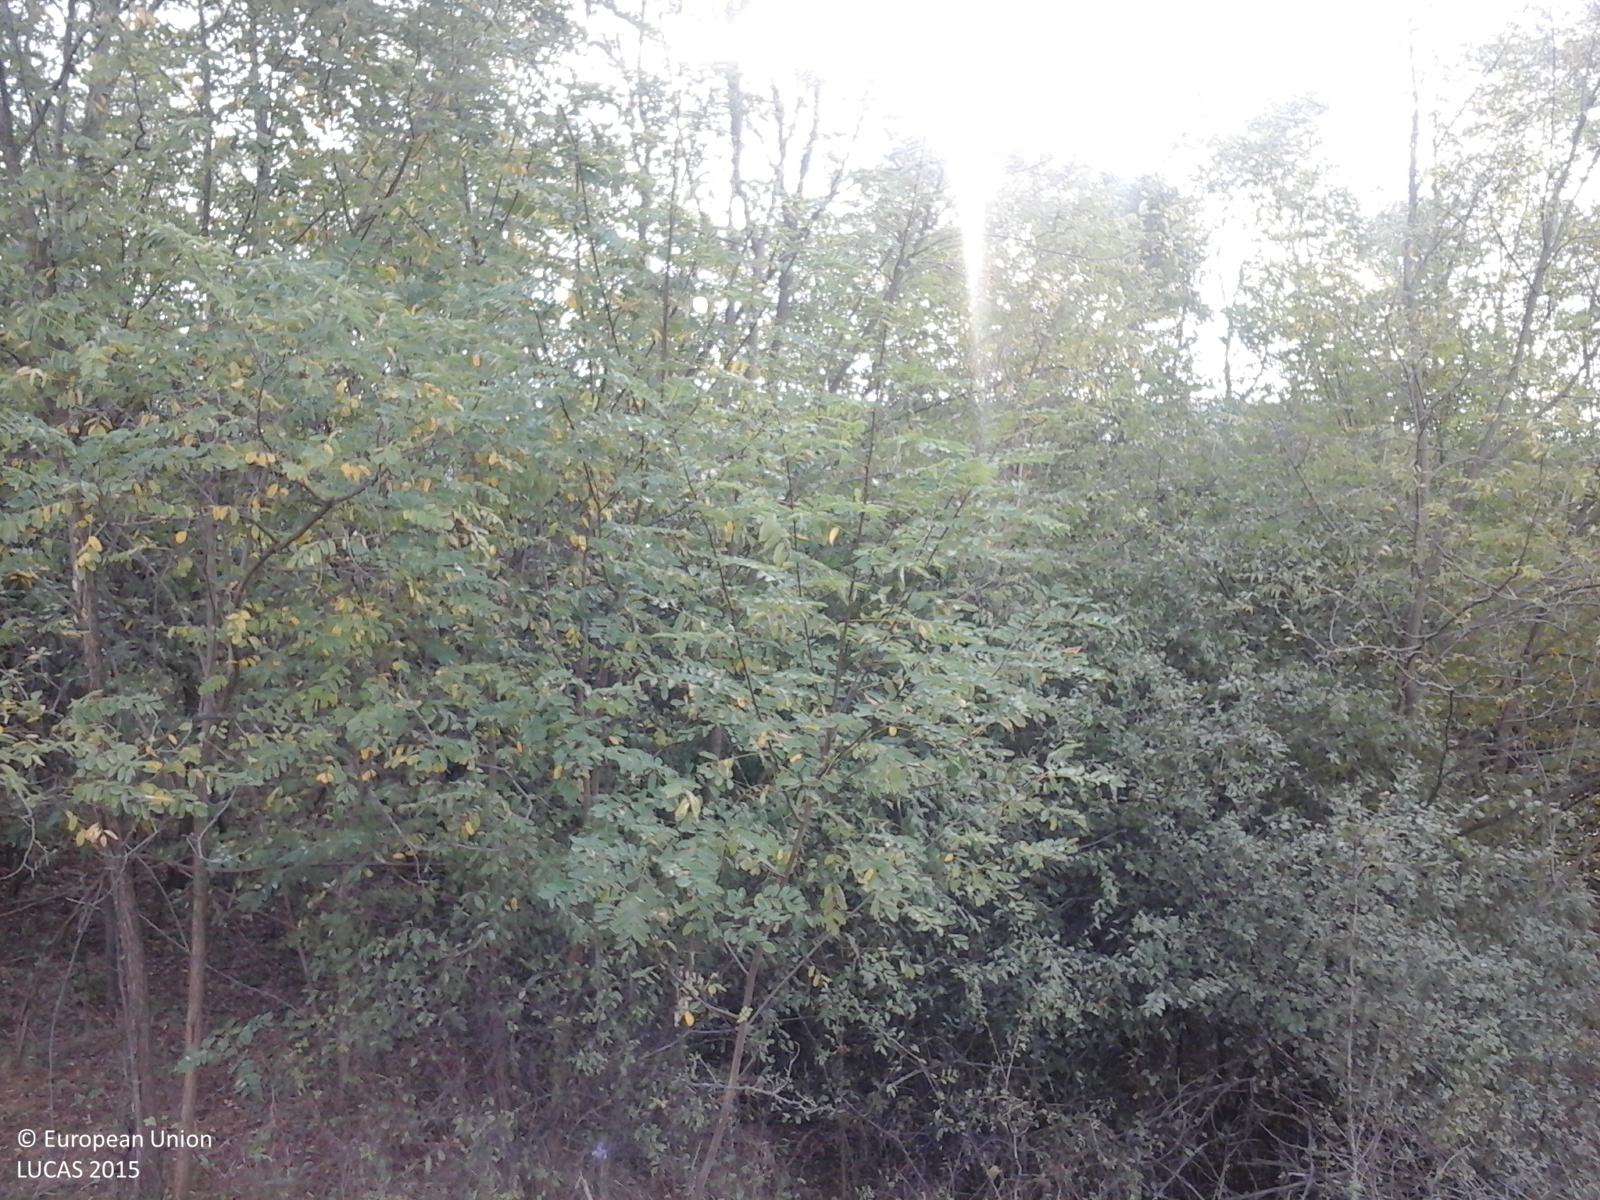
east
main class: Grassland
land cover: Grassland without tree/shrub cover
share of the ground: > 75 %
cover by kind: herbaceous plants 100 %
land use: Agriculture (excluding fallow land and kitchen gardens)
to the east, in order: Grassland without tree/shrub cover; Groves; Broadleaved woodland; Ditches and canals; Broadleaved woodland; Grassland without tree/shrub cover; Broadleaved woodland; Grassland with sparse tree/shrub cover; Shrubland with sparse tree cover; Spontaneously vegetated surfaces
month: September
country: RO
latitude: 47.1565
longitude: 23.4585
